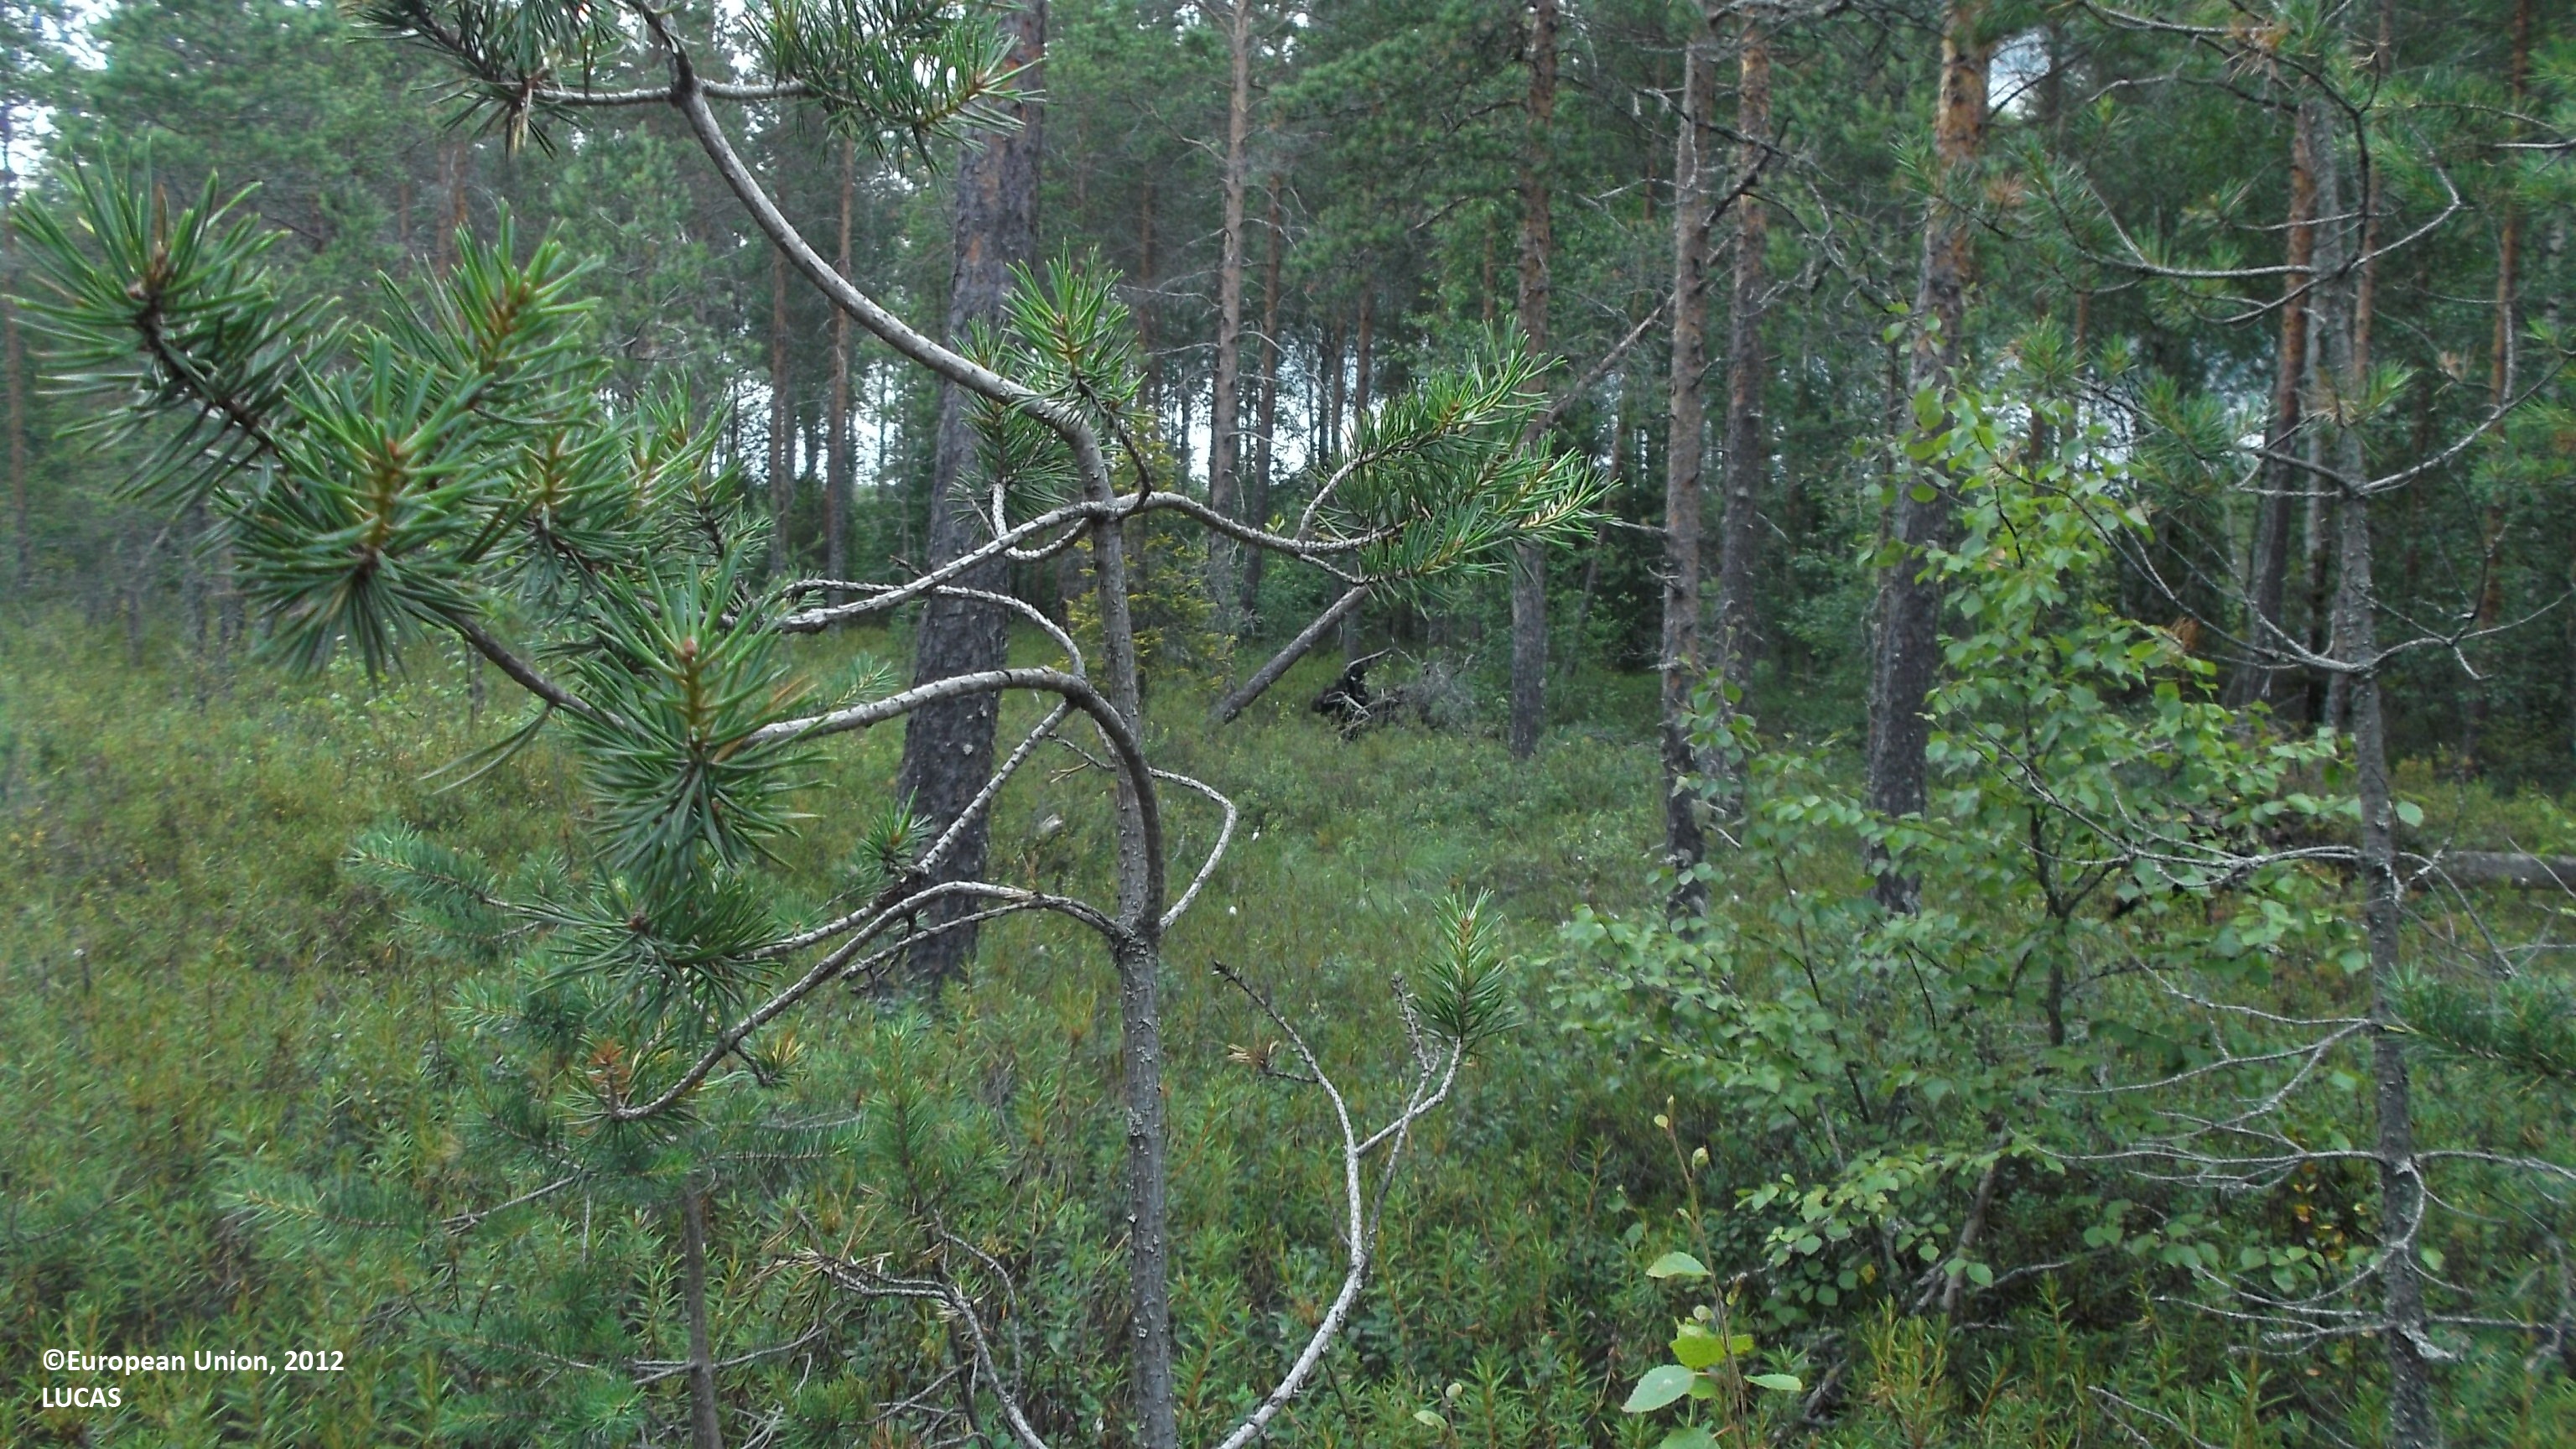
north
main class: Woodland
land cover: Pine dominated coniferous woodland
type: mire and swamp forests
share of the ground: 25 - 50 %
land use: Forestry
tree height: < 5 m
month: July
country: FI
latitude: 63.5470
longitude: 23.2365
